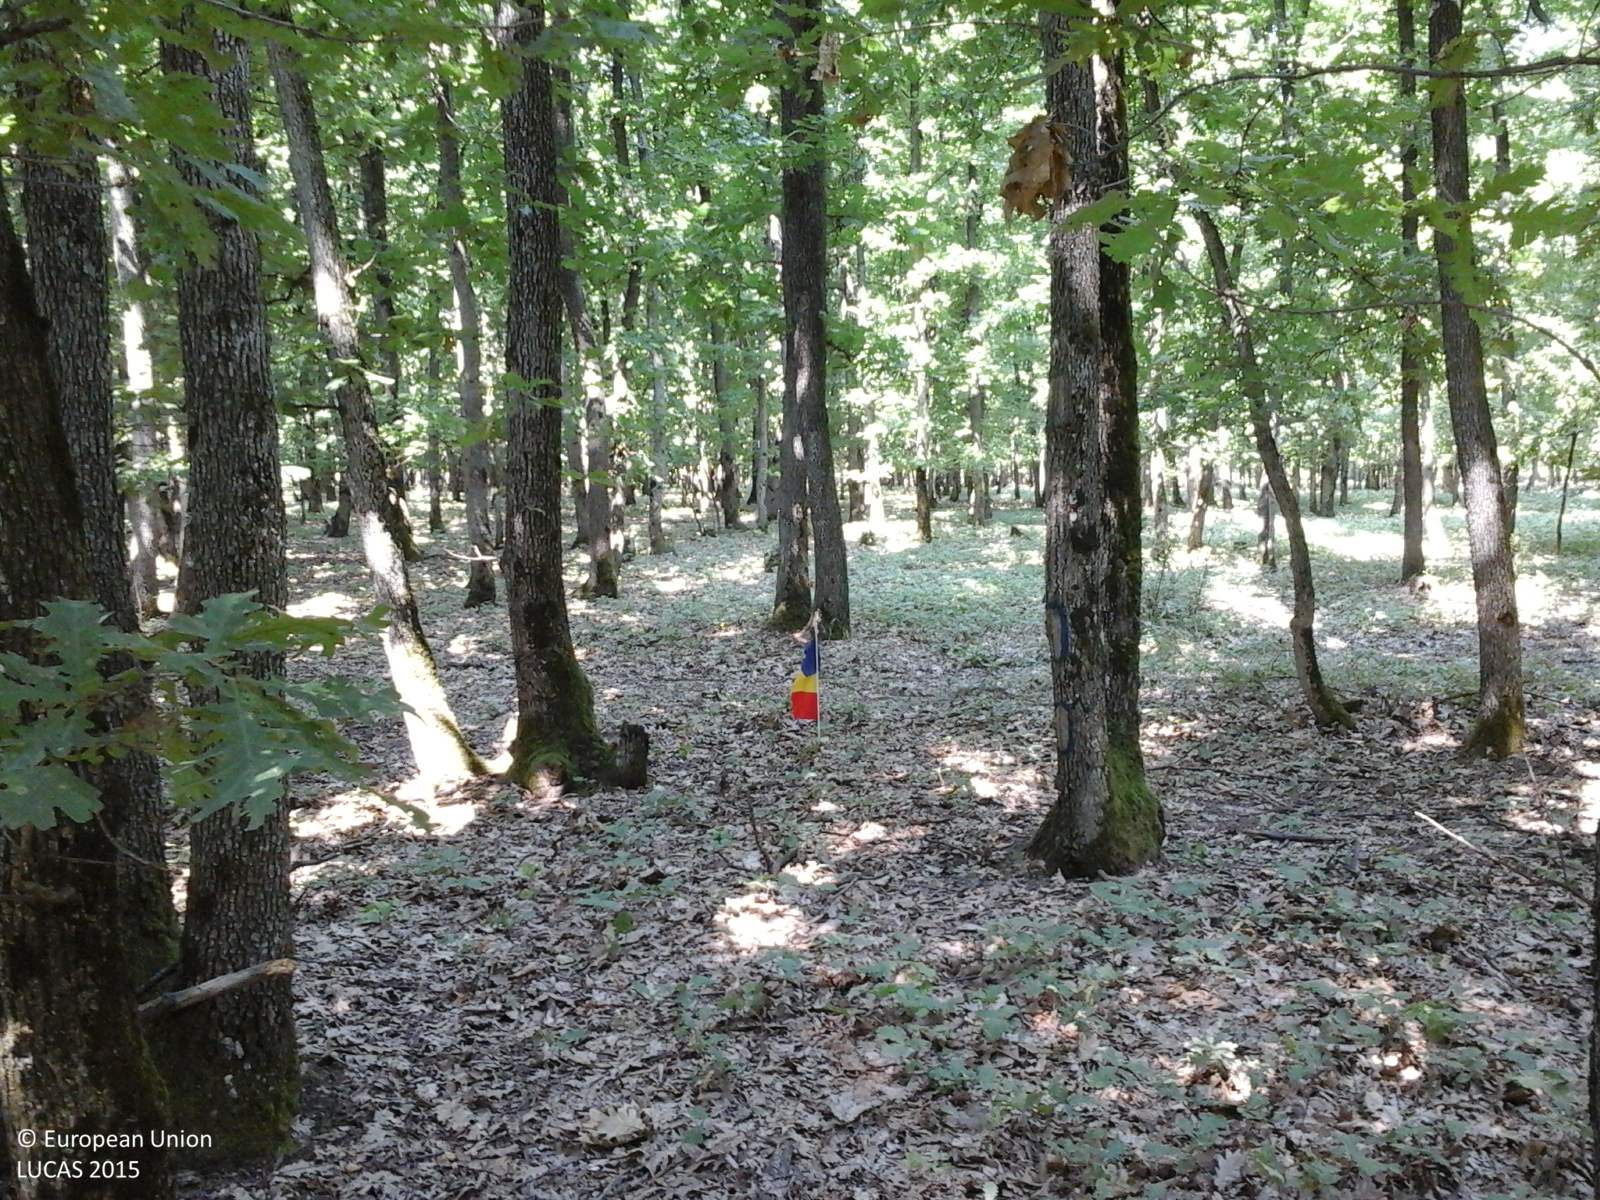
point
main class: Woodland
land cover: Broadleaved woodland
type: acidophilous oak and oak-birch forest
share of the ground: > 75 %
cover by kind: broadleaved forest trees 100 %
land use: Forestry
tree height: > 5 m
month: July
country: RO
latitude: 44.6423
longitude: 24.6369
